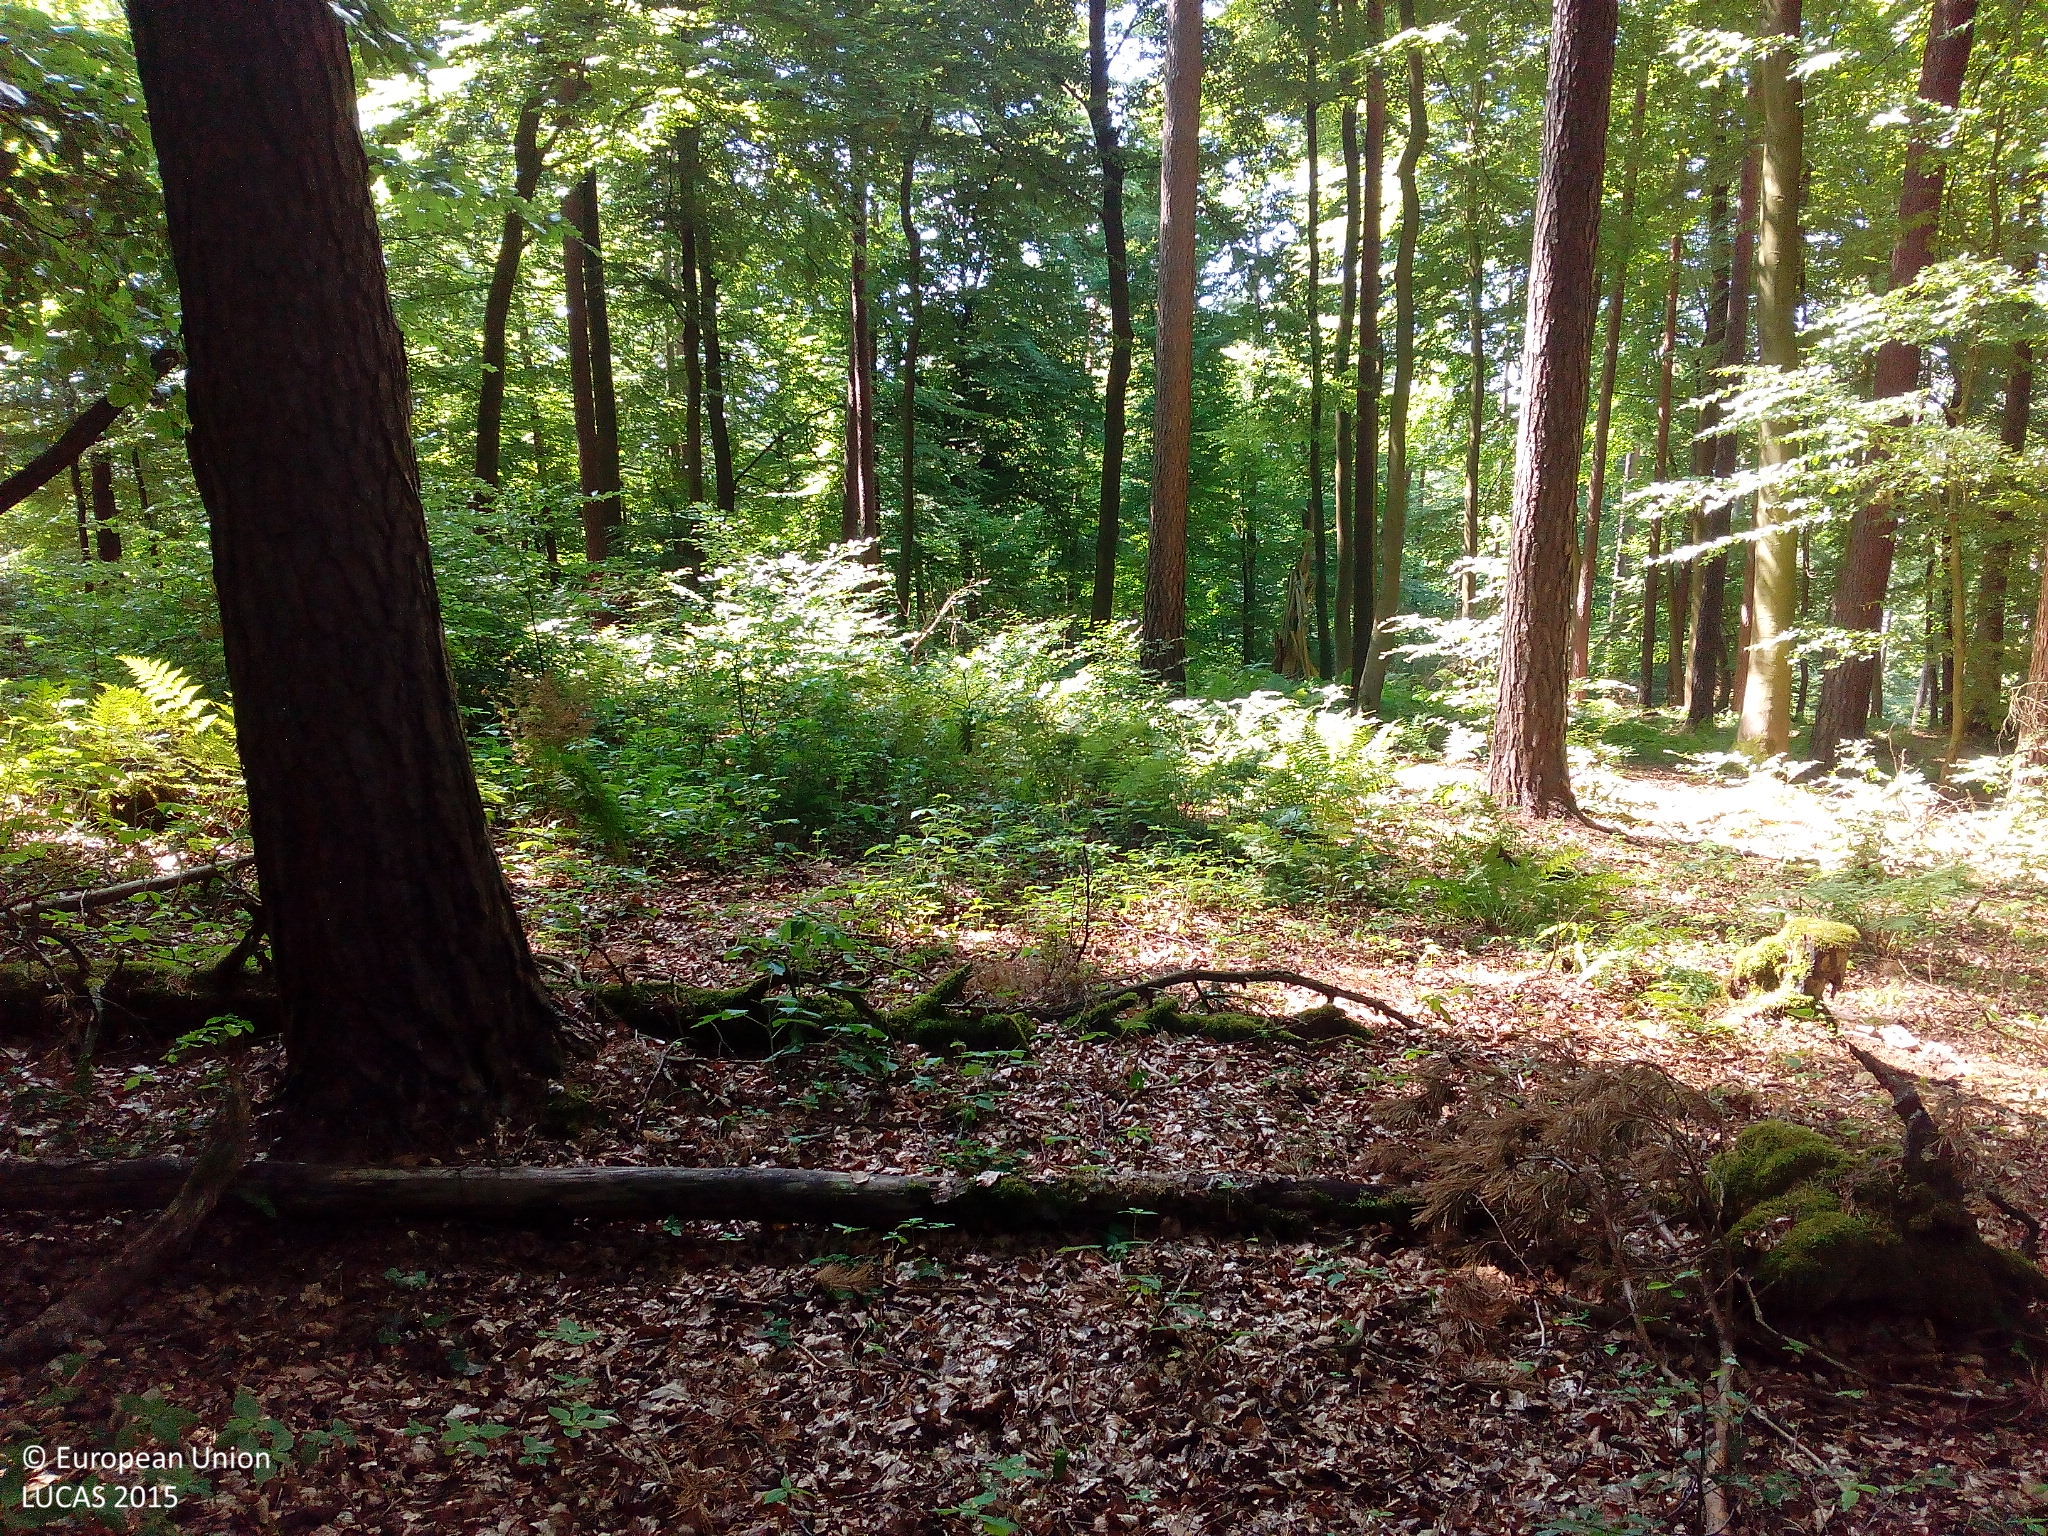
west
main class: Woodland
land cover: Pine dominated mixed woodland
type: hemiboreal forest and nemoral coniferous forest and mixed broadleaved-coniferous forest
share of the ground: > 75 %
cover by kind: broadleaved forest trees 60 %, coniferous forest trees 25 %, unconsolidated bare surface 10 %, shrubs 5 %
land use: Forestry
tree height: > 5 m
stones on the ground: < 10 %
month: July
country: DE
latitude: 50.9753
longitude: 9.9003
